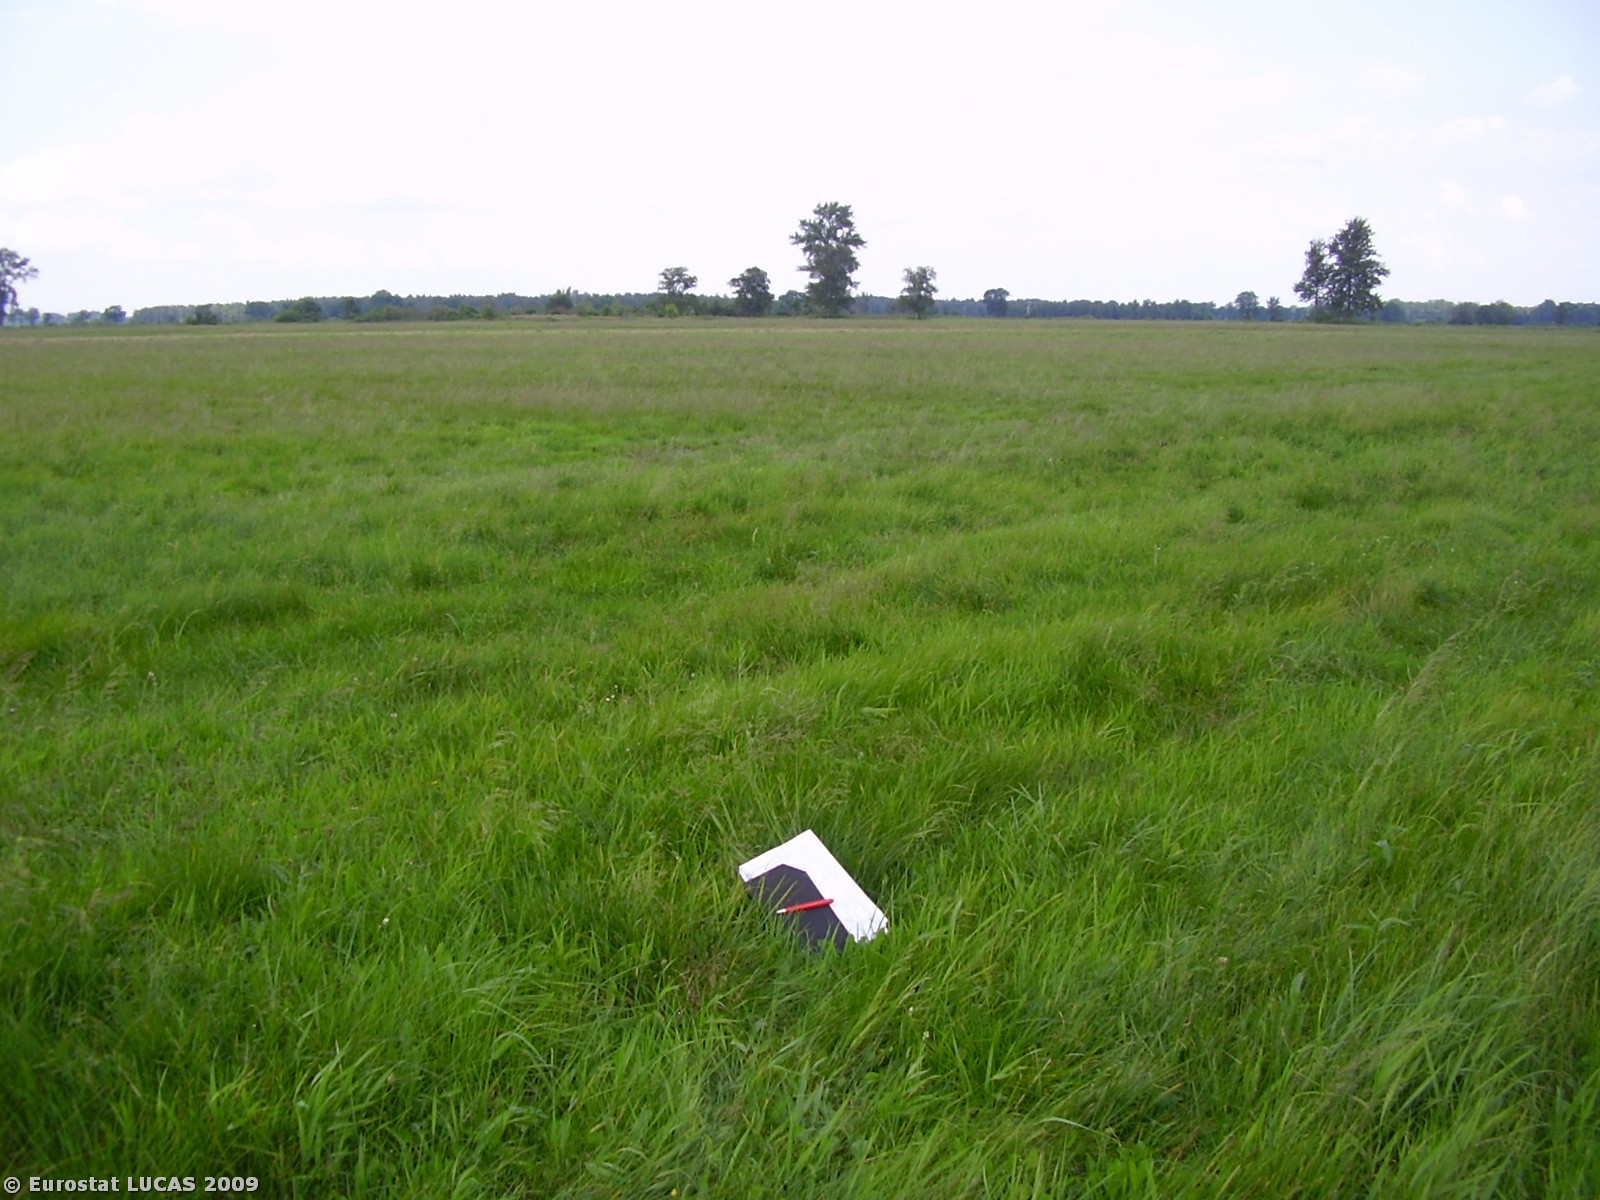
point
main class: Grassland
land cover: Grassland without tree/shrub cover
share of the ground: > 75 %
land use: Agriculture (excluding fallow land and kitchen gardens)
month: July
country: PL
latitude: 52.0304
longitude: 16.2889
